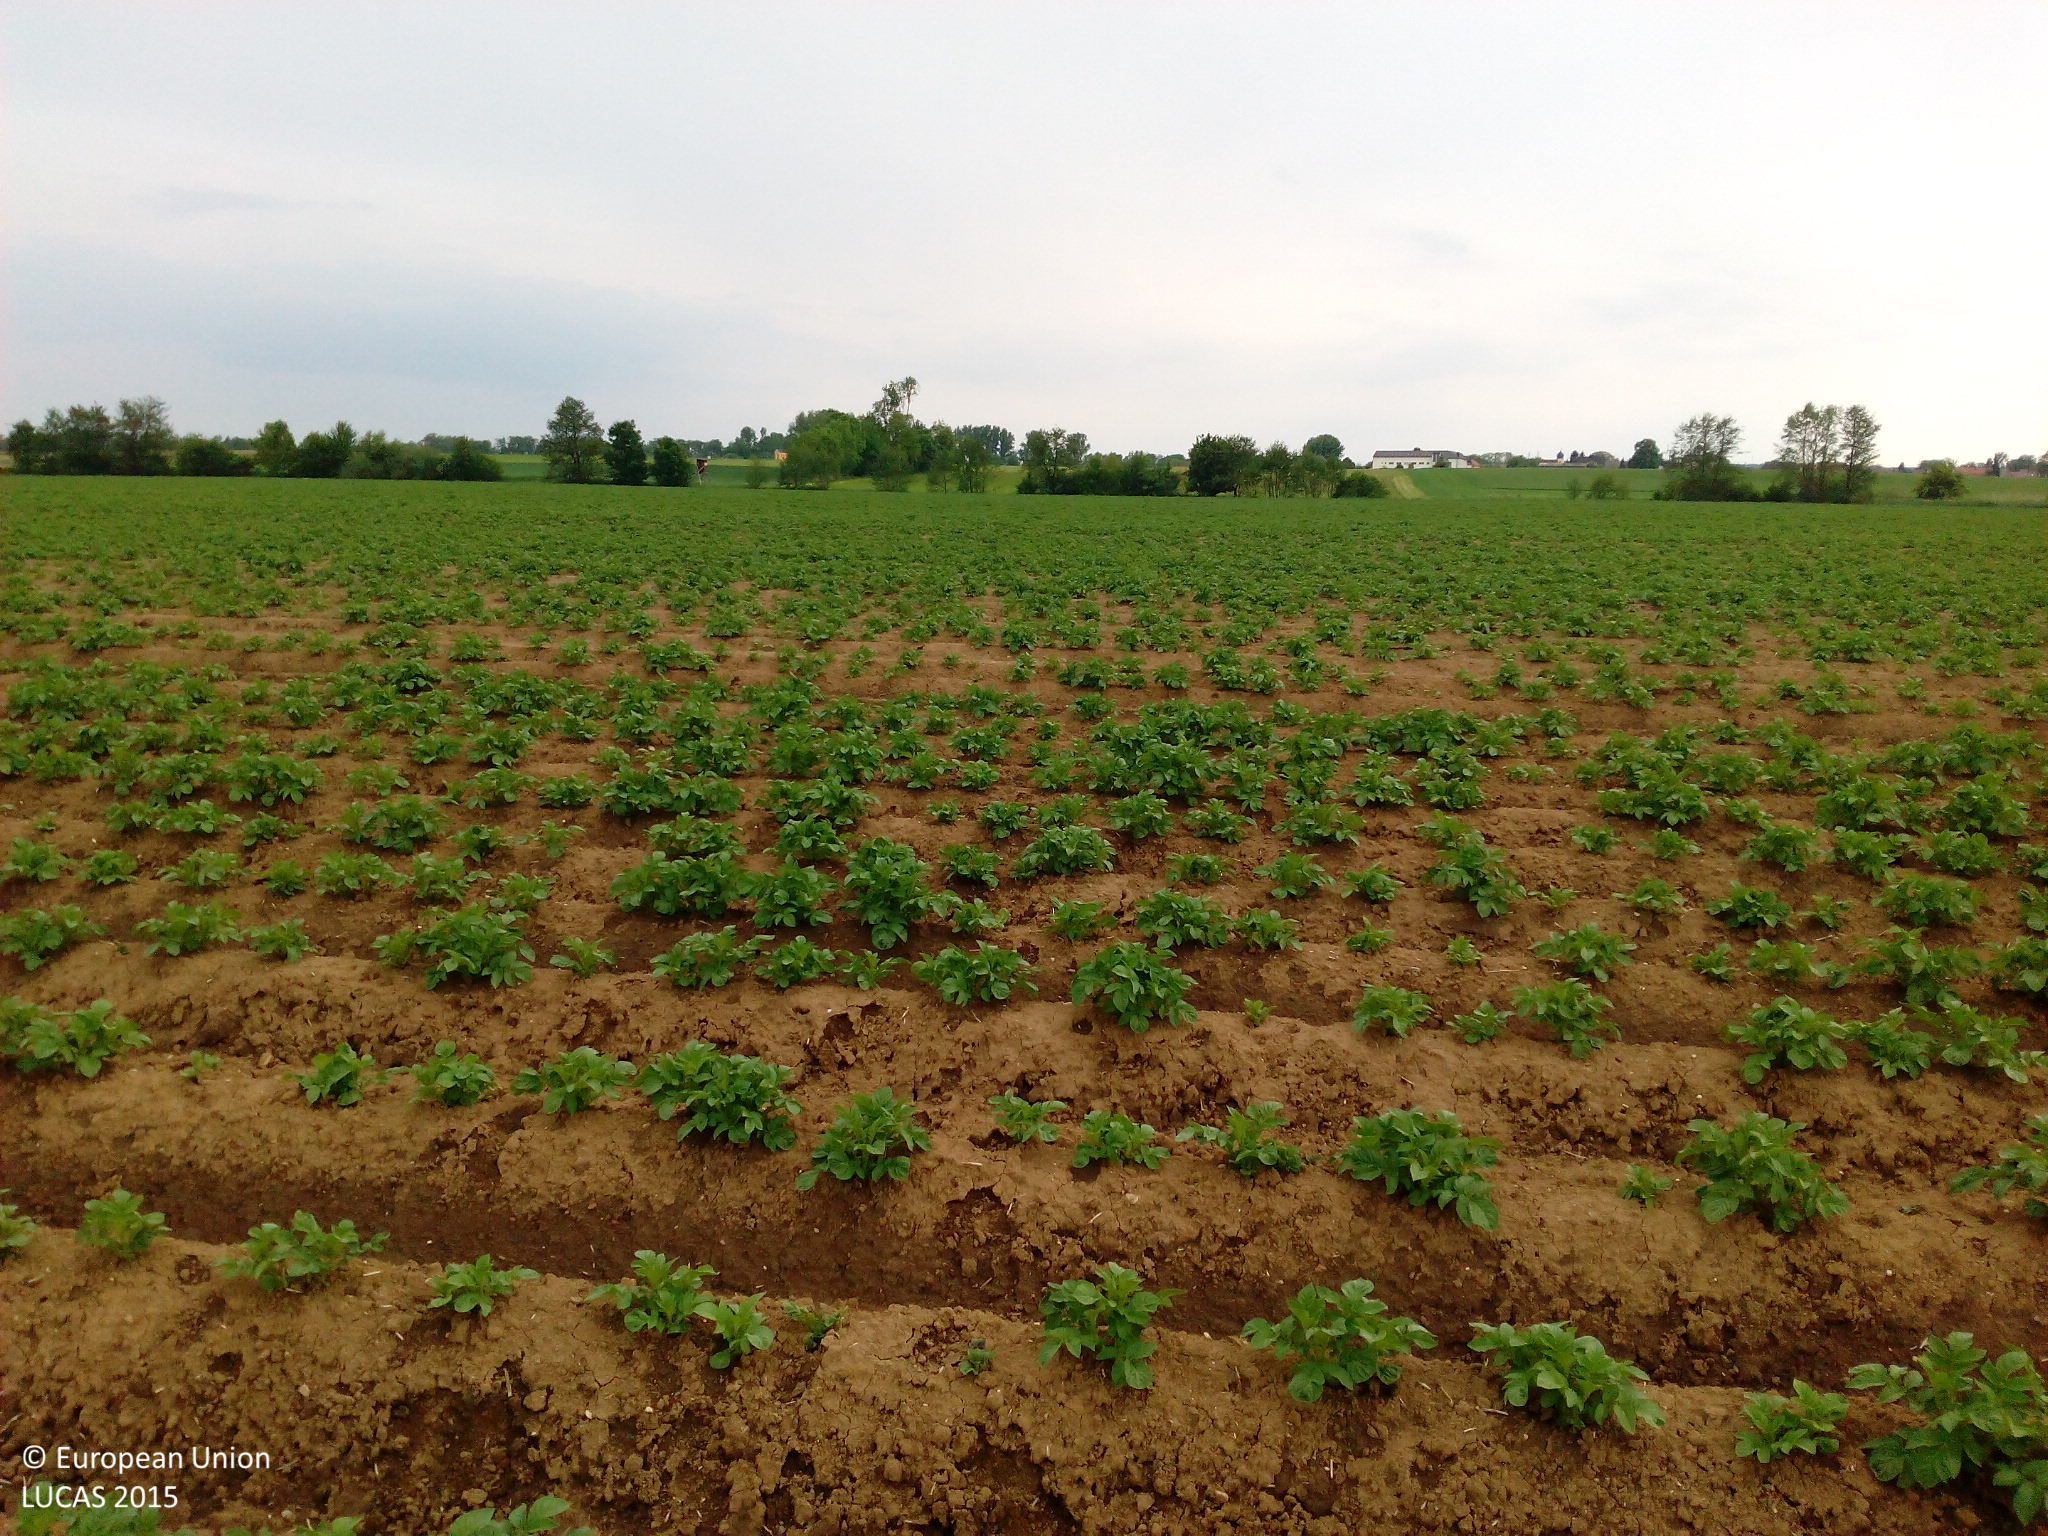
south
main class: Cropland
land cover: Potatoes
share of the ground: 10 - 25 %
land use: Agriculture (excluding fallow land and kitchen gardens)
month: May
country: DE
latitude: 48.9571
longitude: 12.2255
